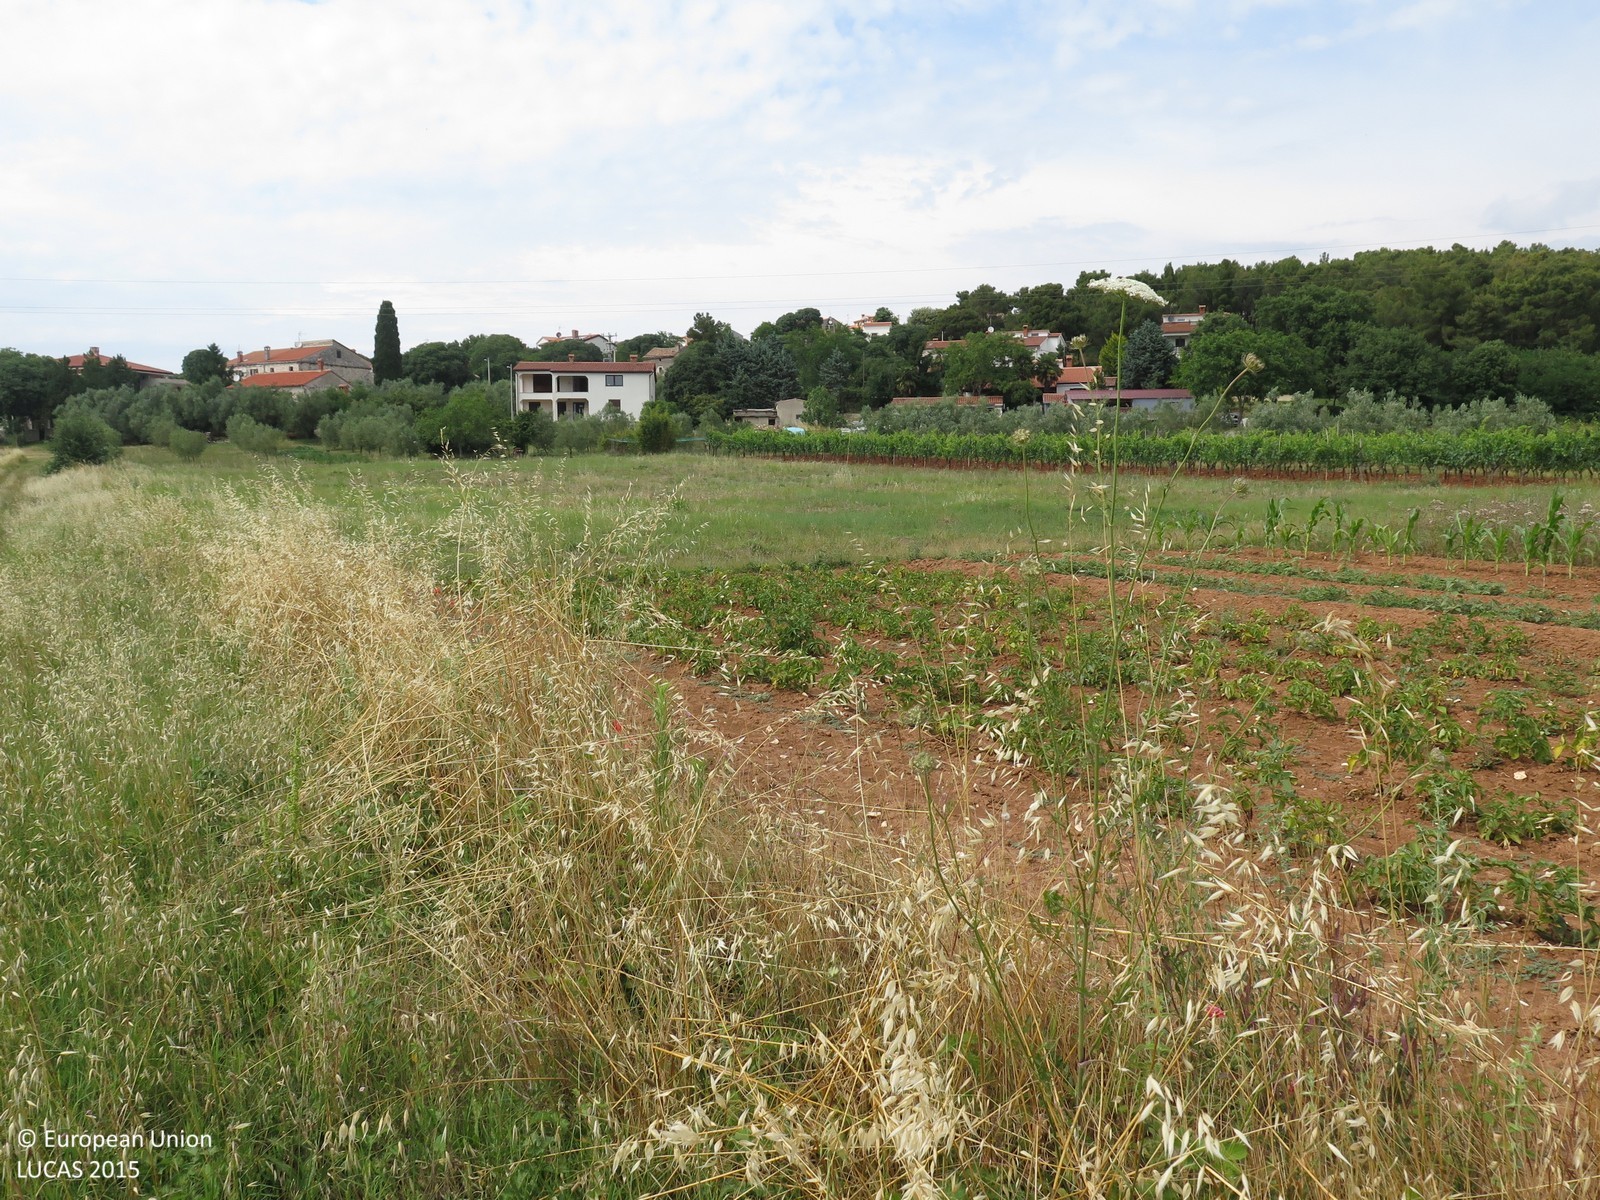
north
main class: Grassland
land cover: Grassland without tree/shrub cover
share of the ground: 25 - 50 %
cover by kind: herbaceous plants 100 %
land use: Agriculture (excluding fallow land and kitchen gardens)
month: June
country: HR
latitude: 45.1897
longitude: 13.6223
